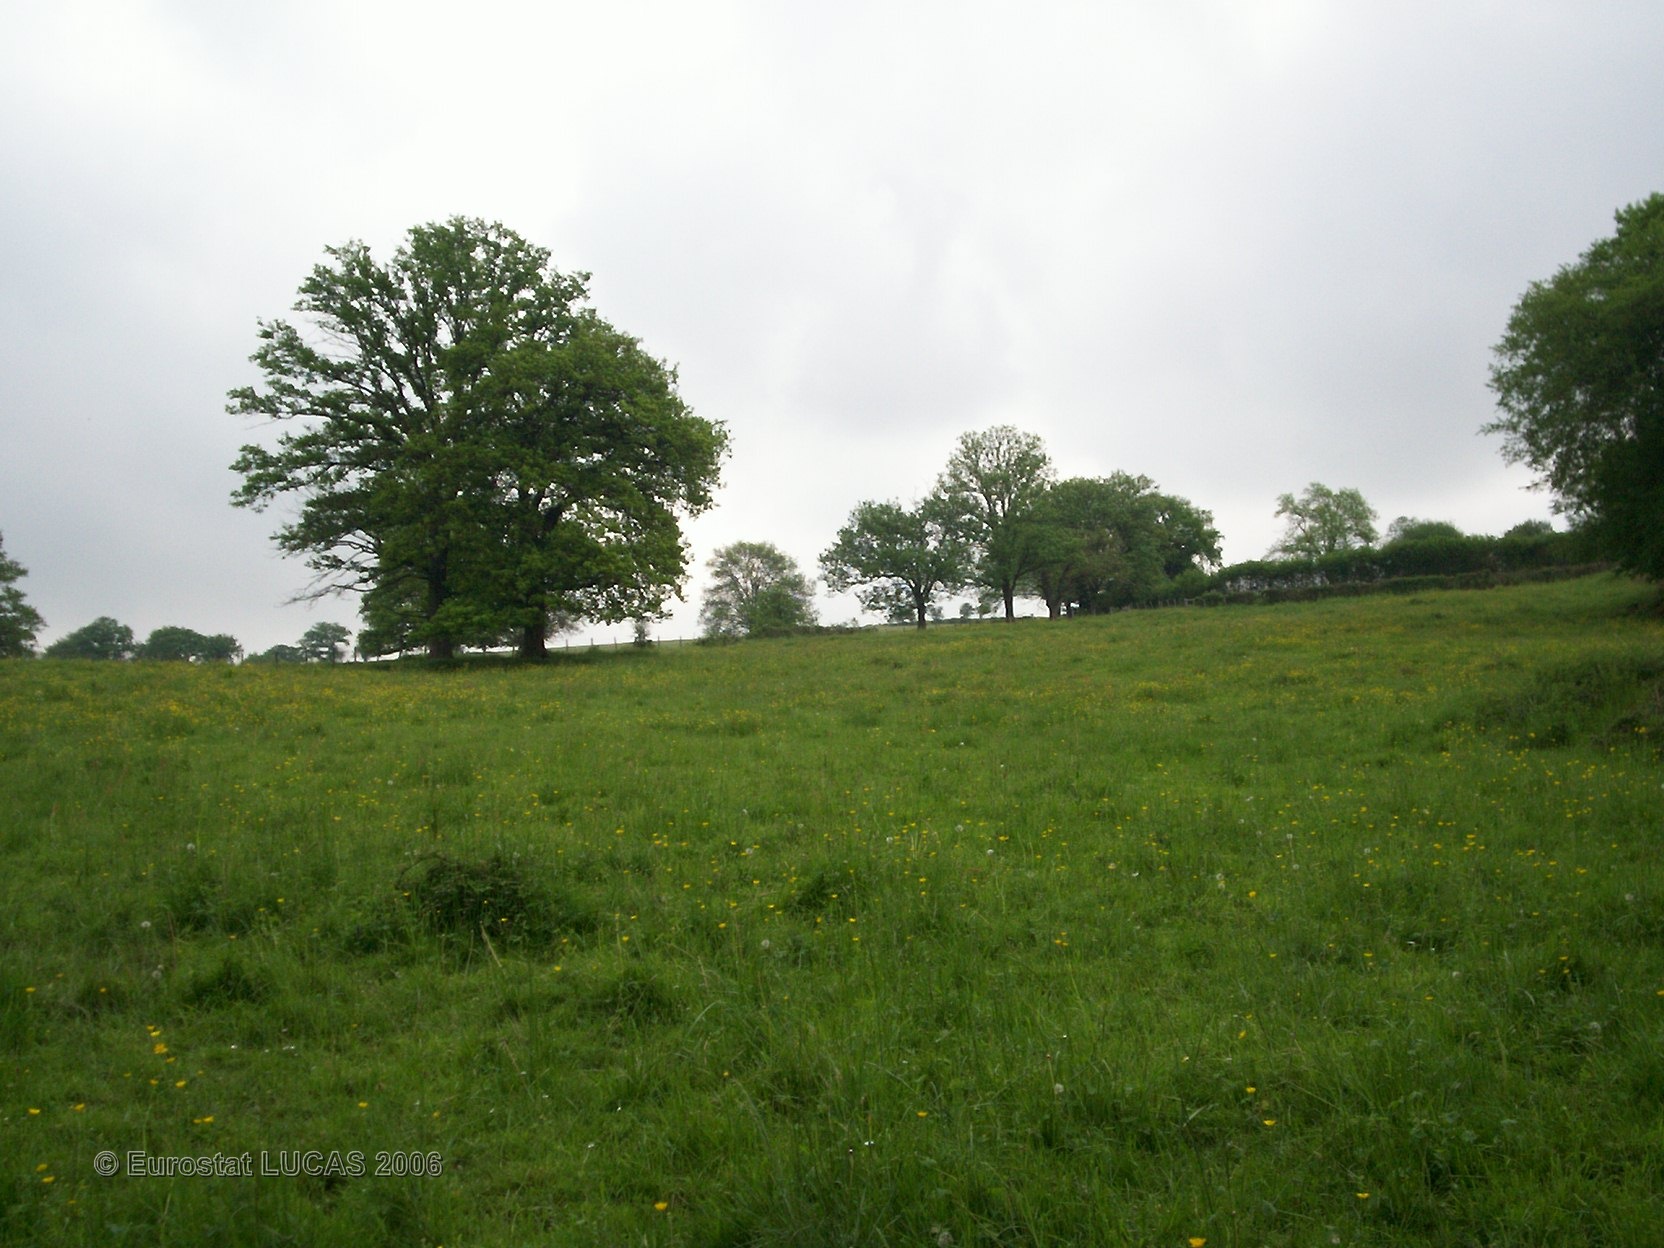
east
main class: Grassland
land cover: Grassland with sparse tree/shrub cover
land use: Agriculture (excluding fallow land and kitchen gardens)
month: May
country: FR
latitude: 46.5110
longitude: 4.7495
